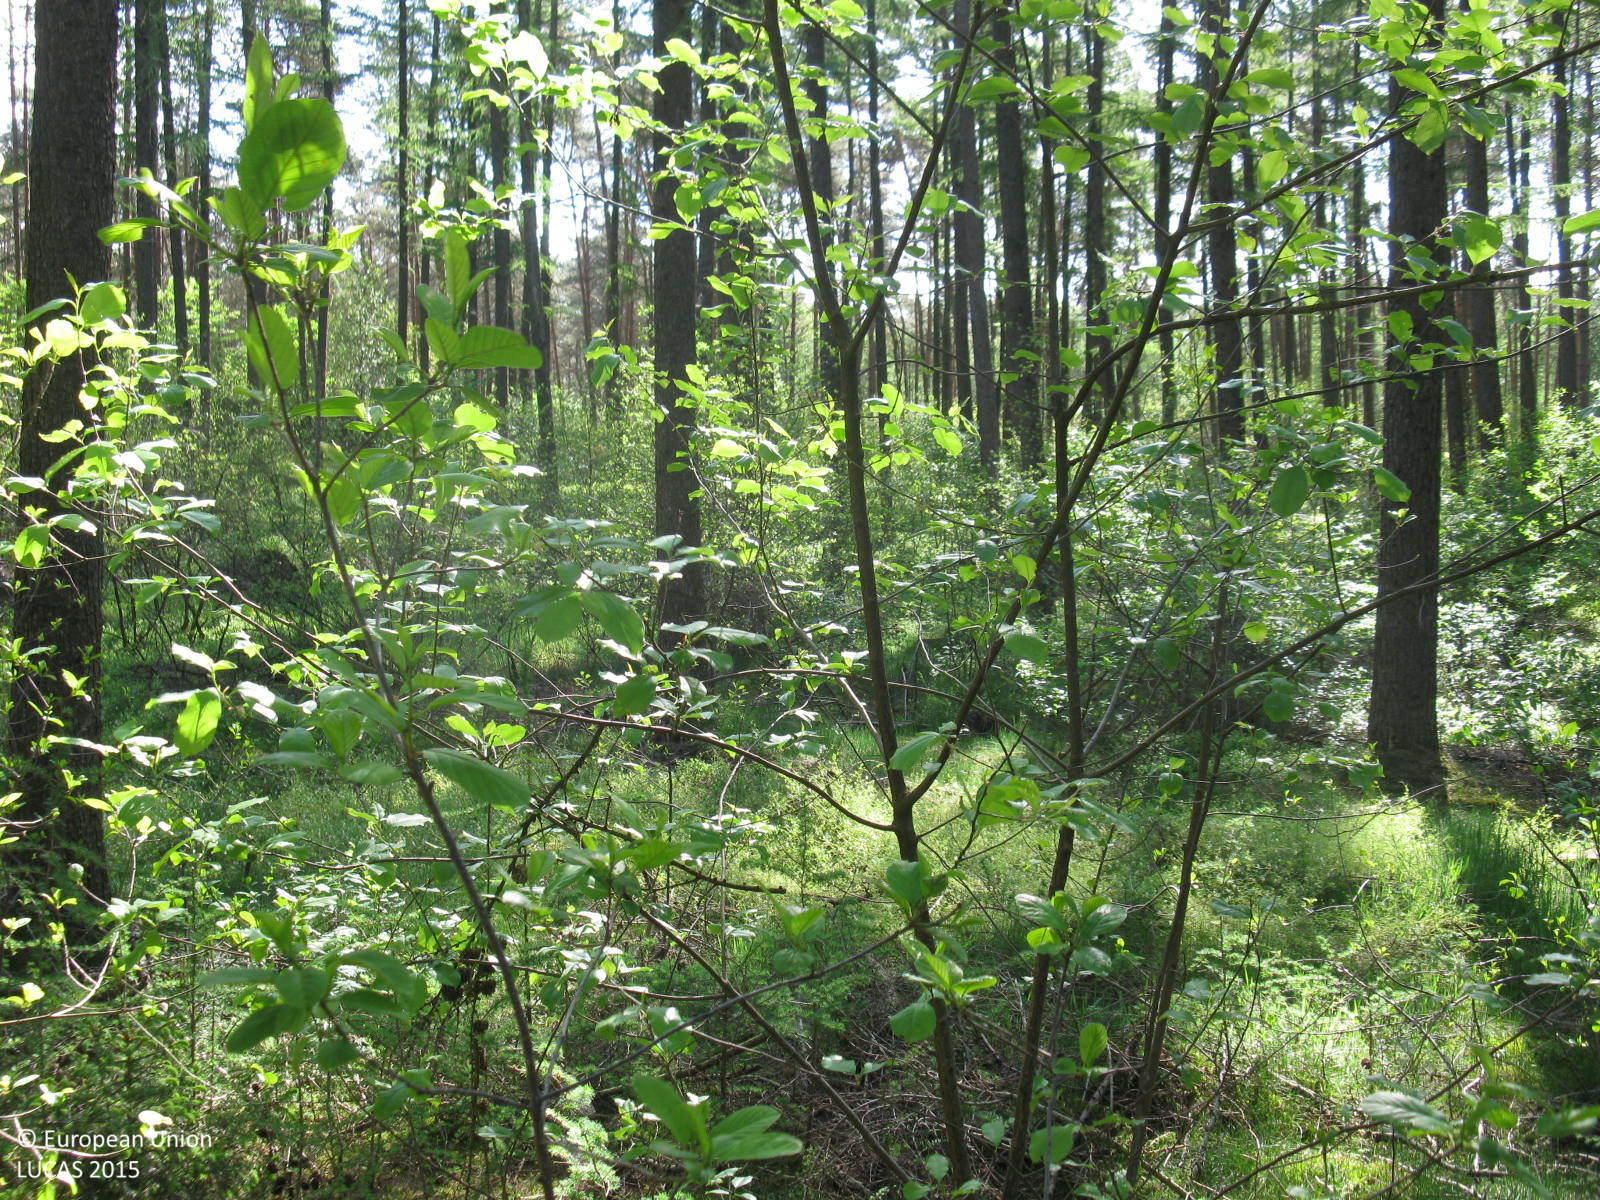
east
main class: Woodland
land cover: Other coniferous woodland
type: hemiboreal forest and nemoral coniferous forest and mixed broadleaved-coniferous forest
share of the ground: > 75 %
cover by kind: coniferous forest trees 100 %
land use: Forestry
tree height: > 5 m
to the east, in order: Other coniferous woodland; Pine dominated coniferous woodland; Other coniferous woodland; Paved roads, cycling and walking lanes; Grass margins; Paved roads, cycling and walking lanes; Pine dominated mixed woodland; Railways; Broadleaved woodland; Tracks
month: May
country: DE
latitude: 52.8147
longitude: 7.3149
